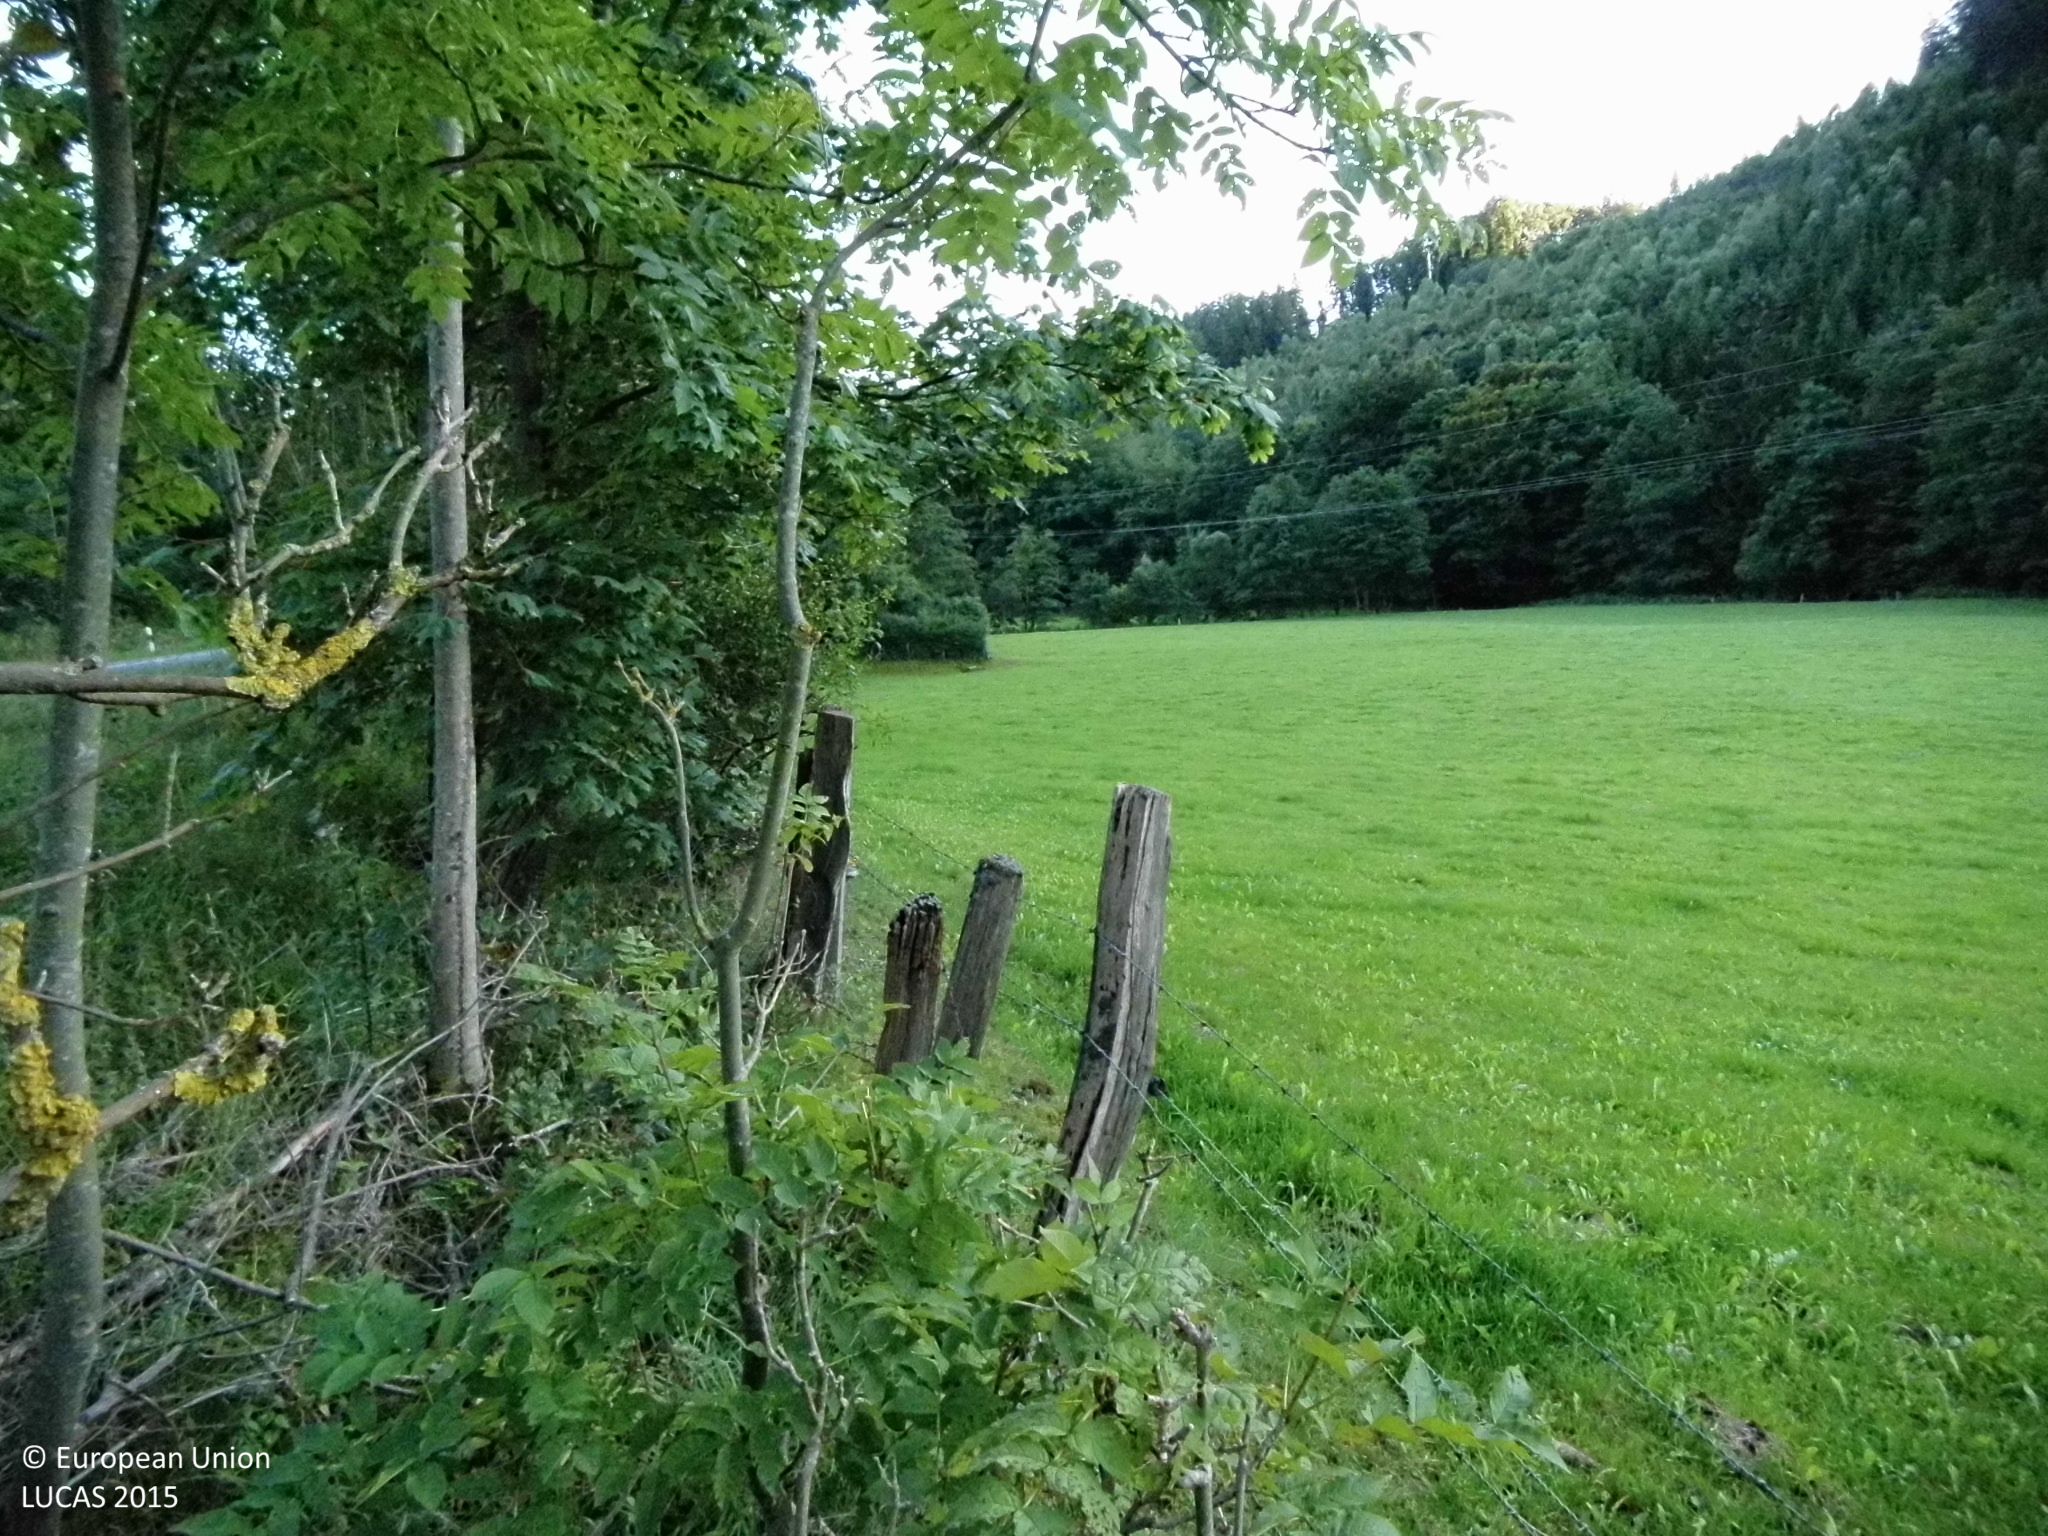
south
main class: Grassland
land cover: Grassland without tree/shrub cover
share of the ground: > 75 %
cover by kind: herbaceous plants 100 %
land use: Agriculture (excluding fallow land and kitchen gardens)
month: September
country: DE
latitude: 51.3252
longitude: 8.4936
